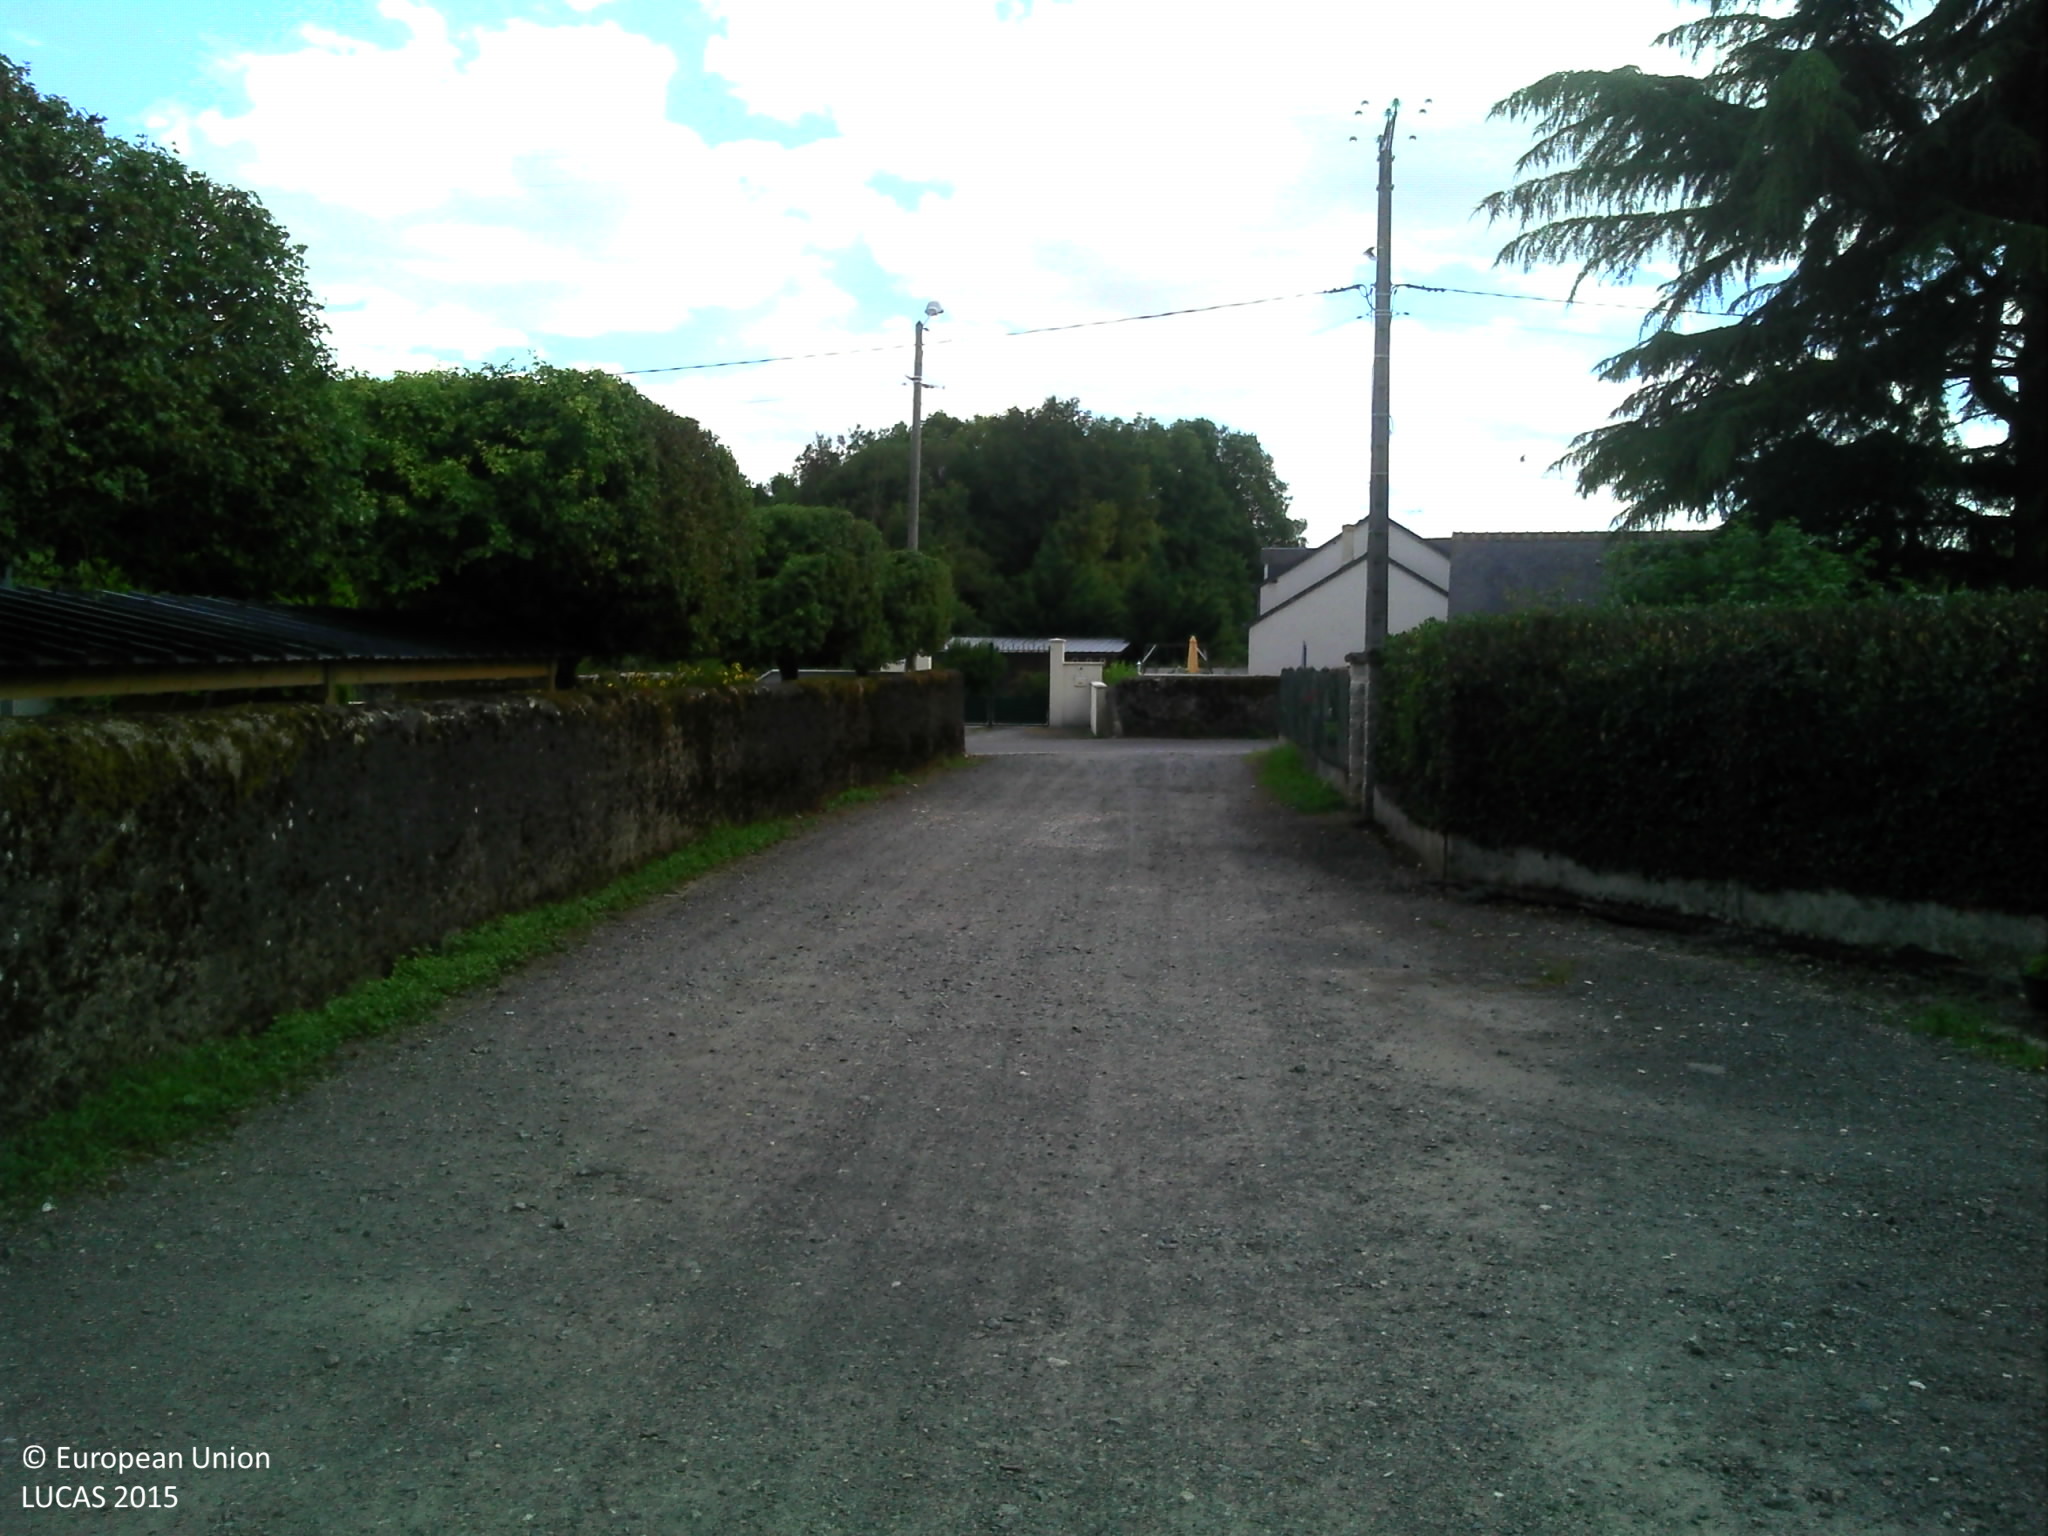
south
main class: Woodland
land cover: Pine dominated mixed woodland
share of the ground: > 75 %
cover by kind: coniferous forest trees 40 %, herbaceous plants 35 %, broadleaved forest trees 25 %
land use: Residential
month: June
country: FR
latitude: 47.3074
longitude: 0.7355
